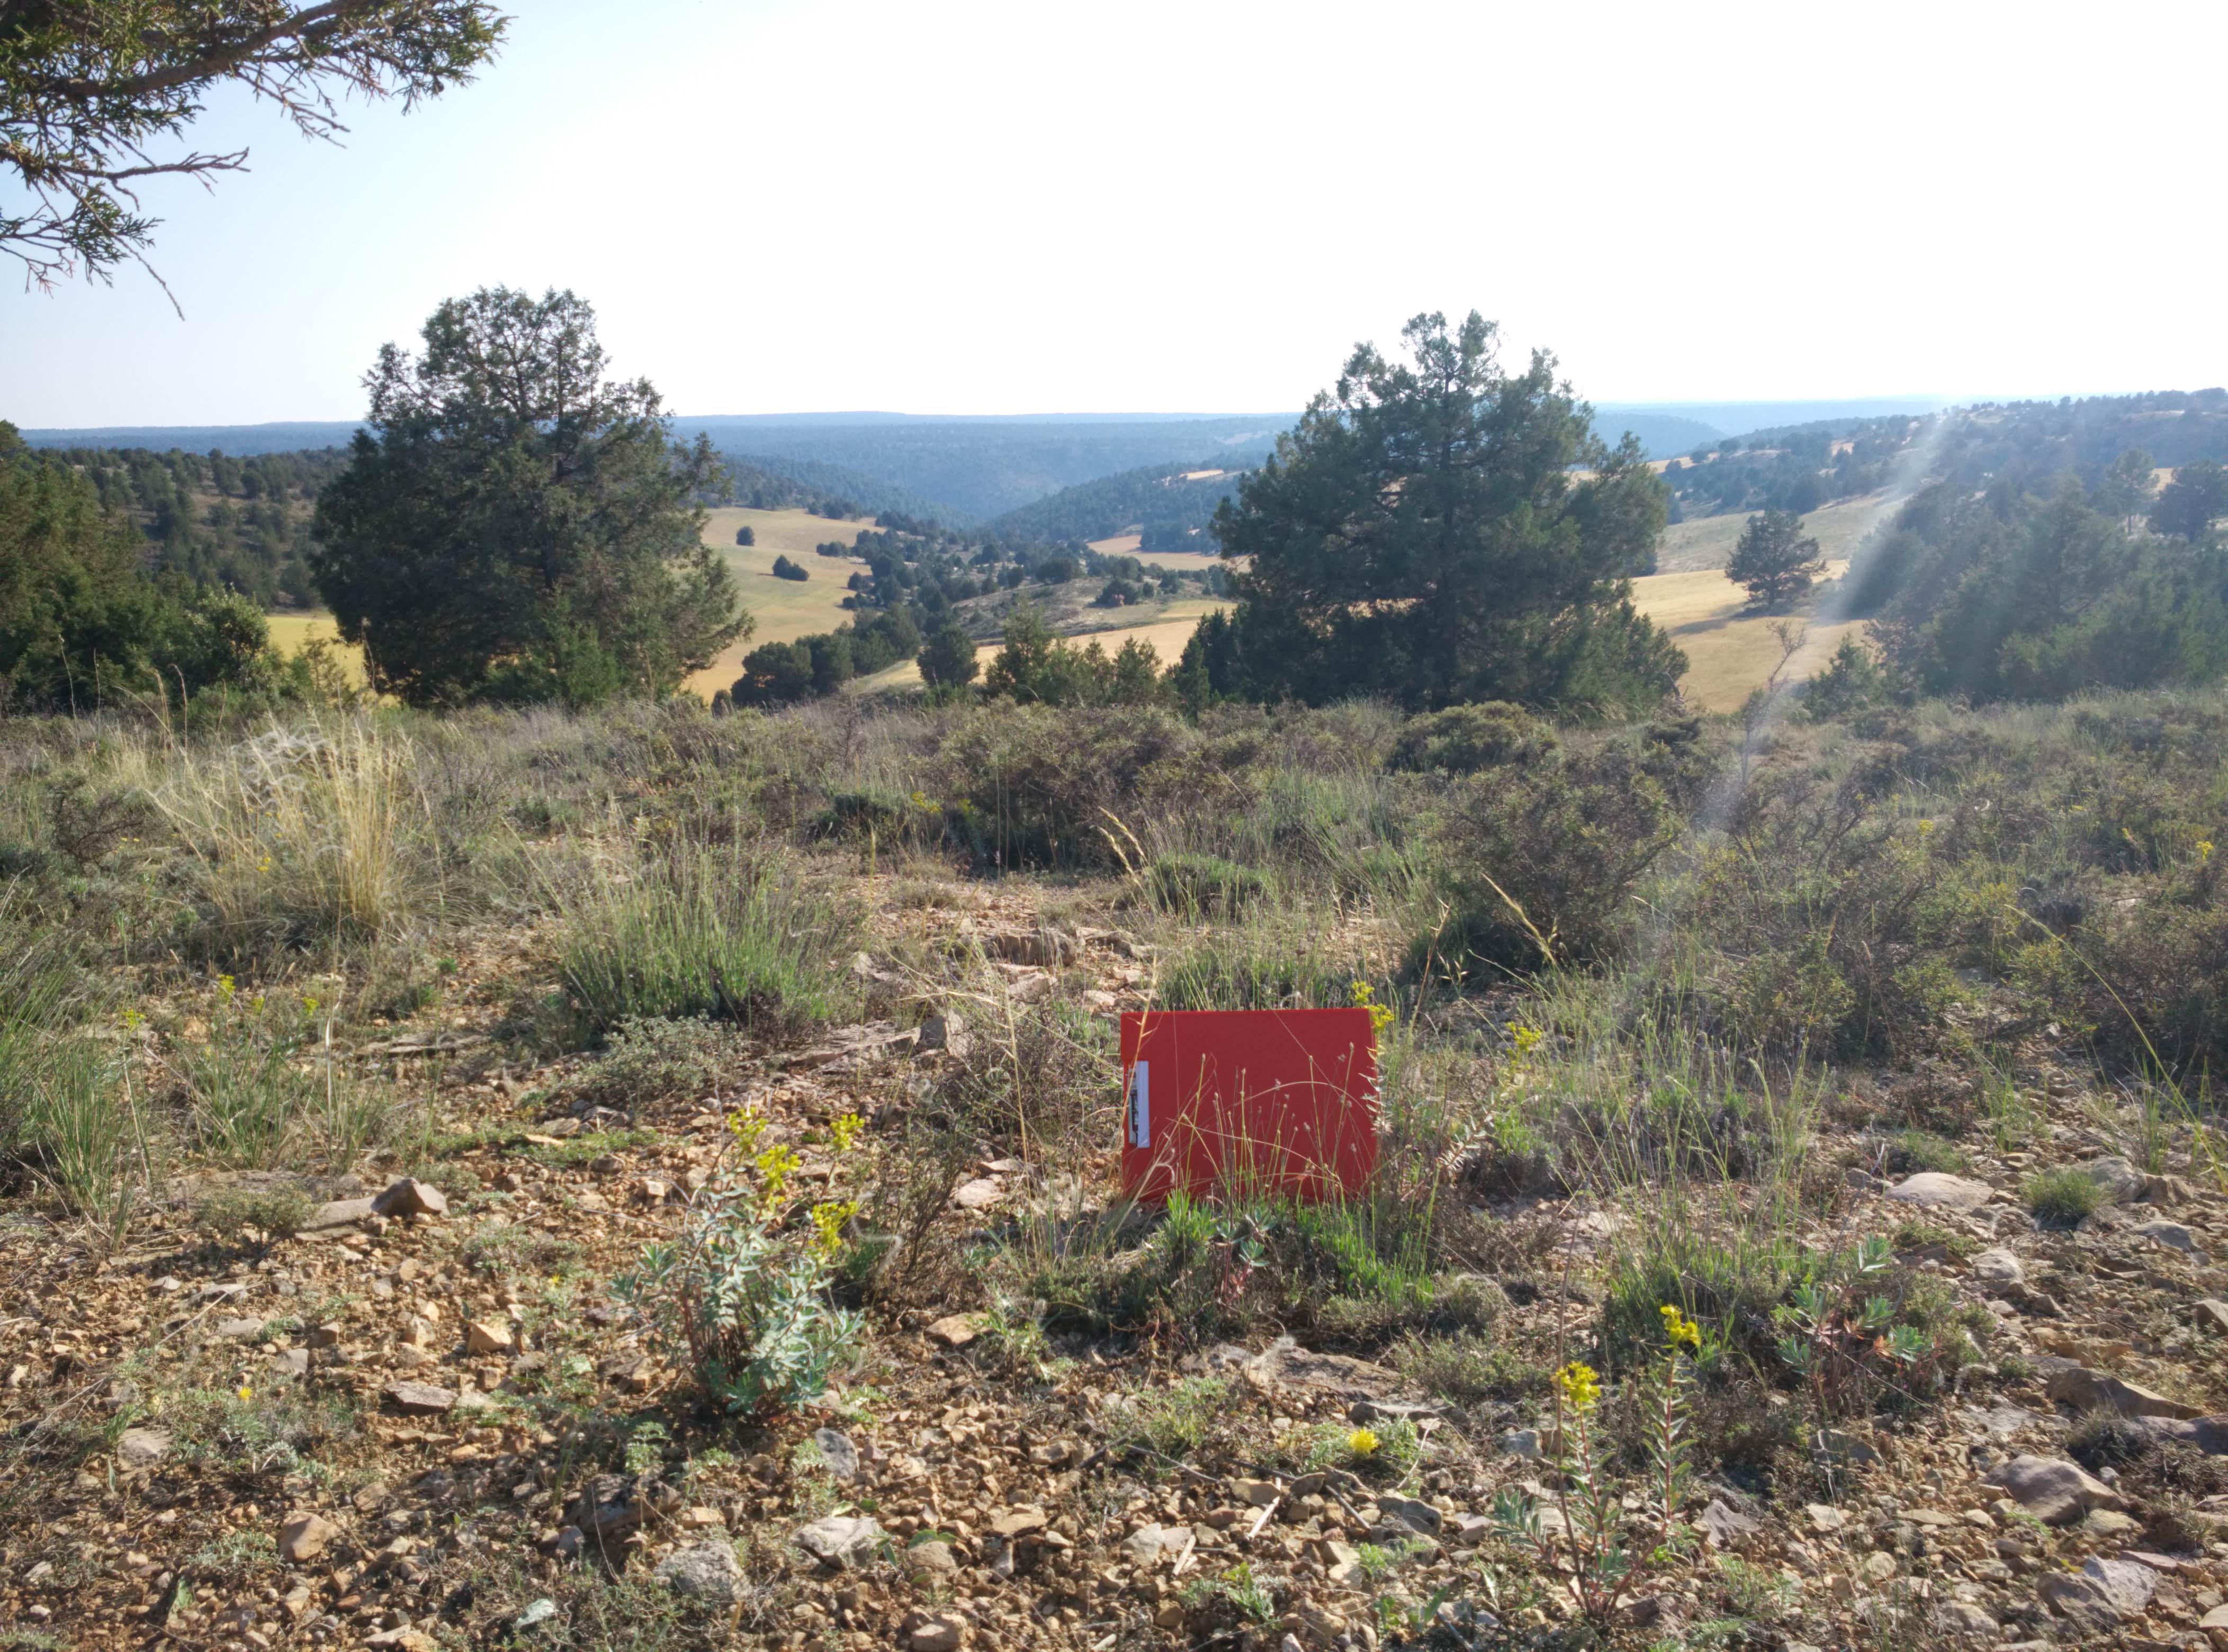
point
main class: Shrubland
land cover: Shrubland with sparse tree cover
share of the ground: 25 - 50 %
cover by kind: unconsolidated bare surface 50 %, shrubs 40 %, coniferous forest trees 5 %, herbaceous plants 5 %
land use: Semi-natural and natural areas not in use
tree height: > 5 m
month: June
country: ES
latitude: 40.7757
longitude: -1.9534
